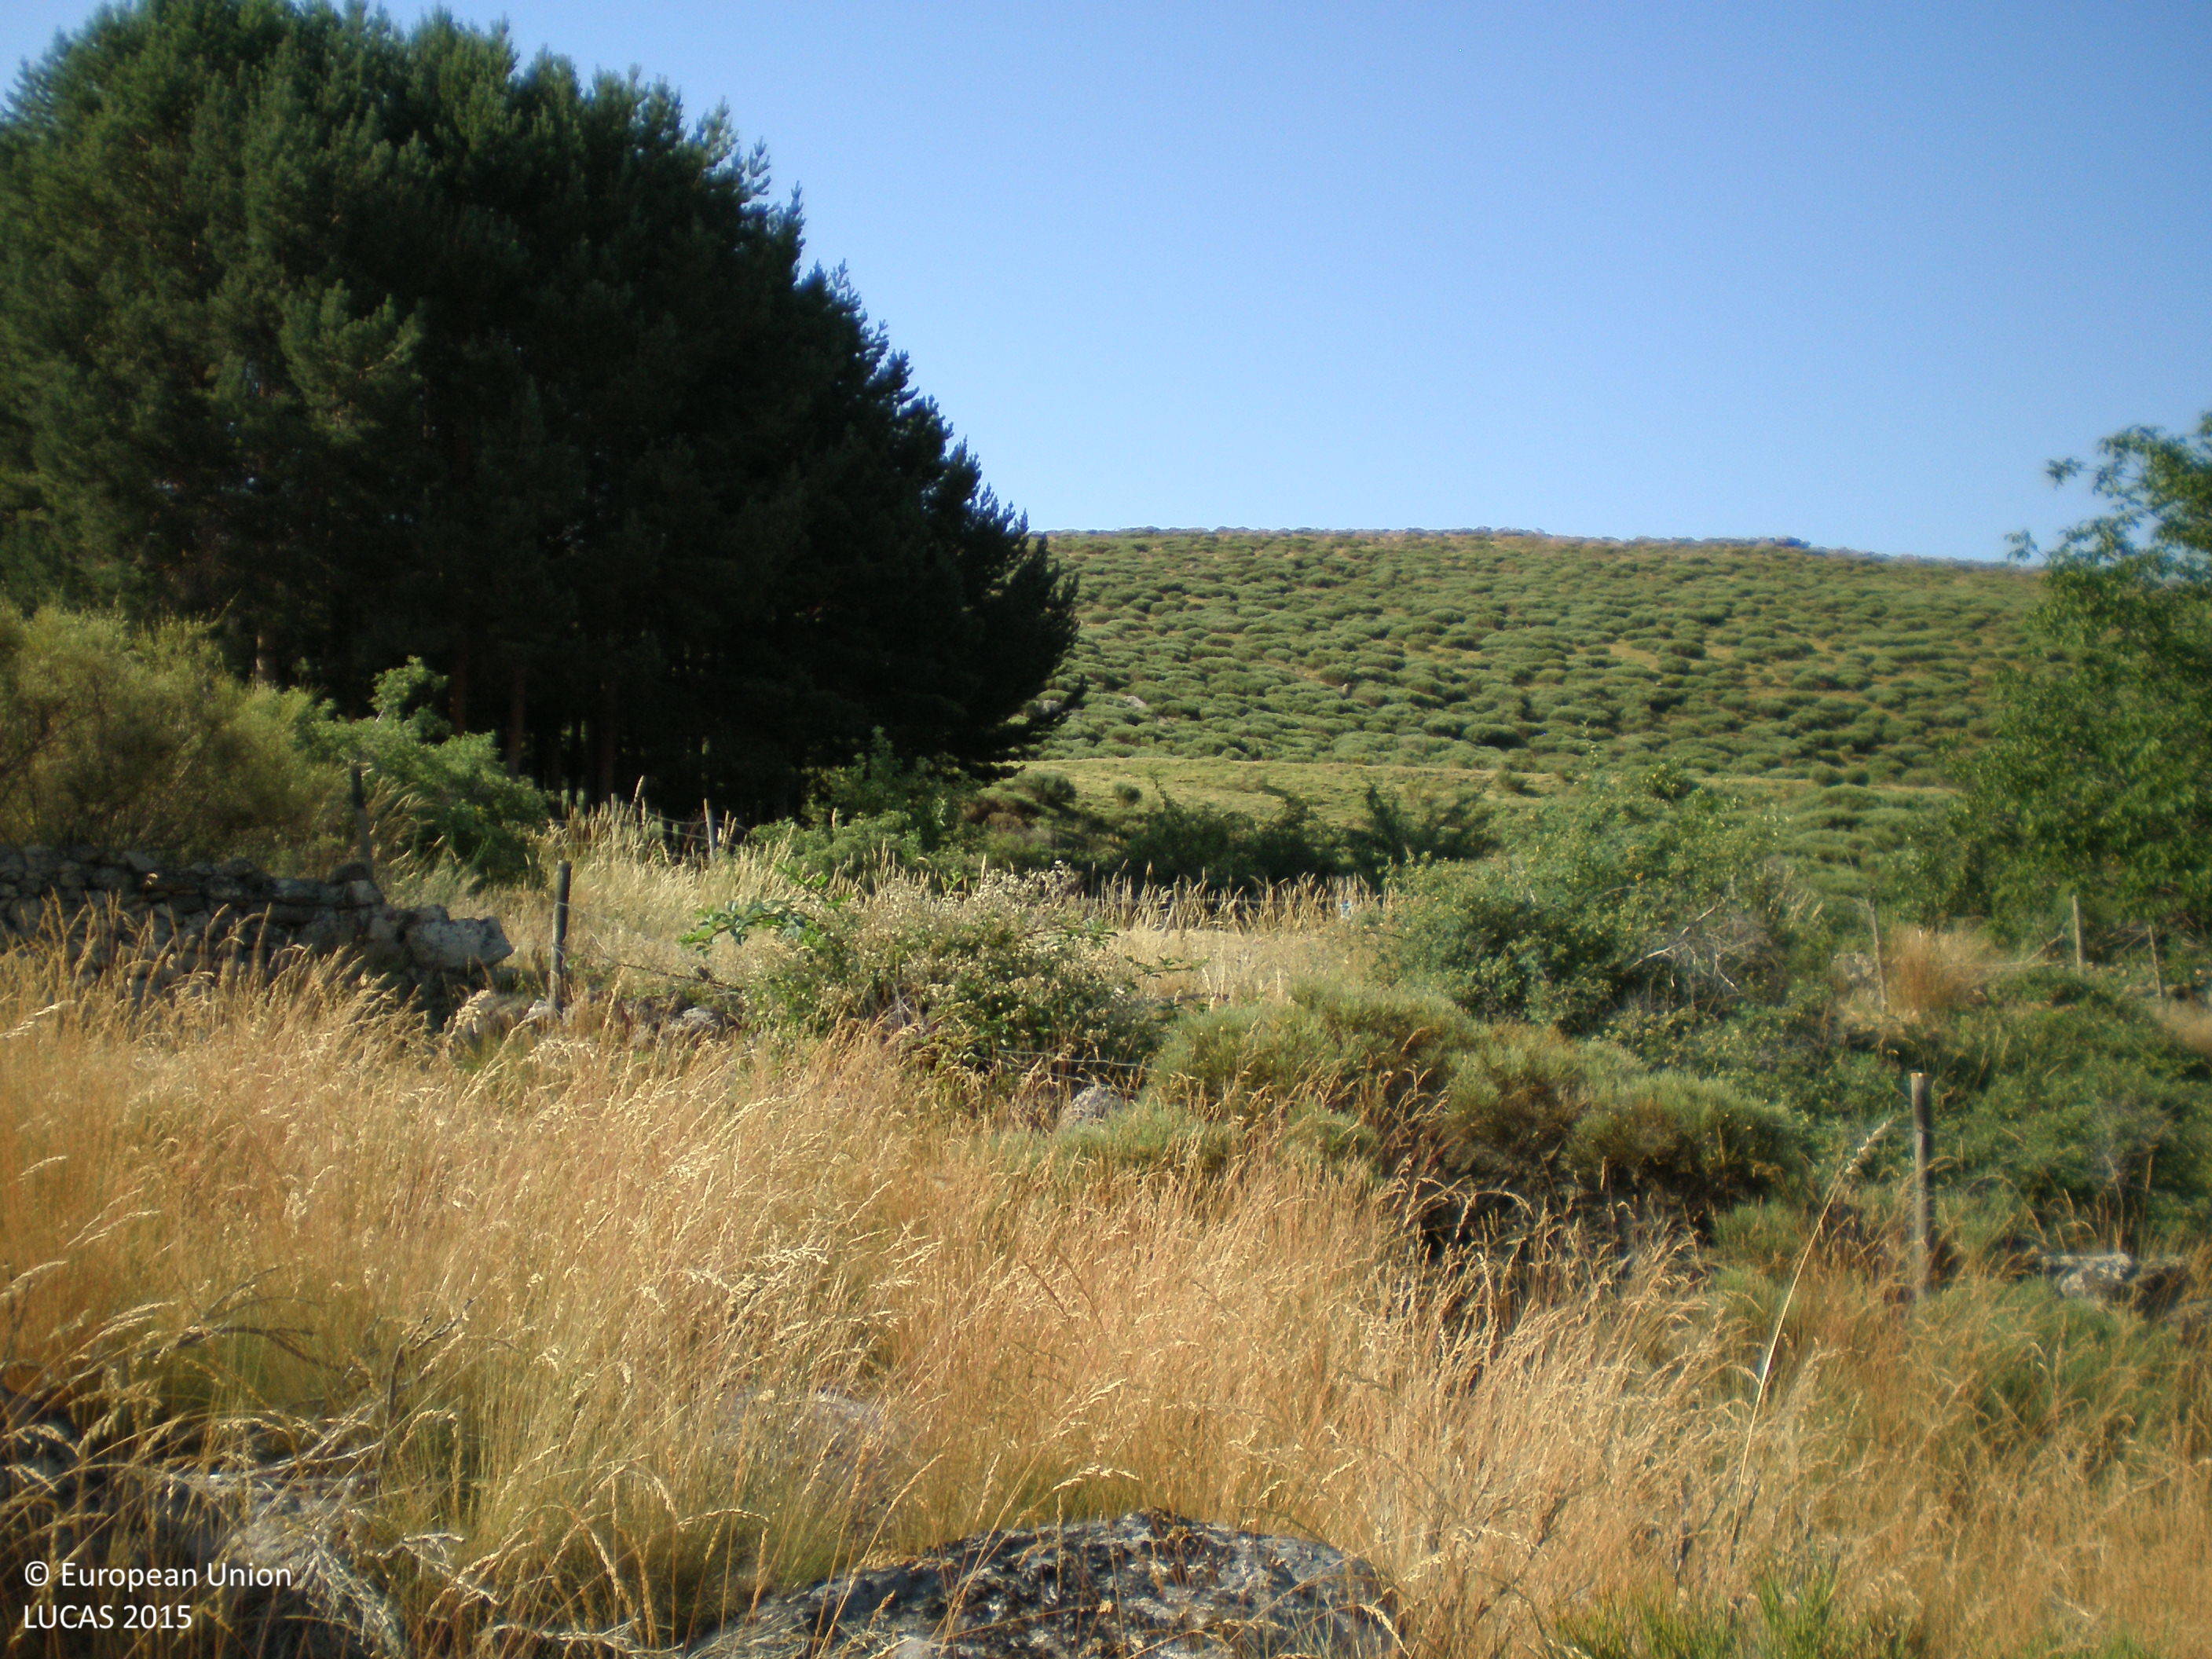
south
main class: Shrubland
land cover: Shrubland without tree cover
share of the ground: > 75 %
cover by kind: shrubs 80 %, herbaceous plants 20 %
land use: Abandoned areas
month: July
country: ES
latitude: 40.4158
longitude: -5.0846
